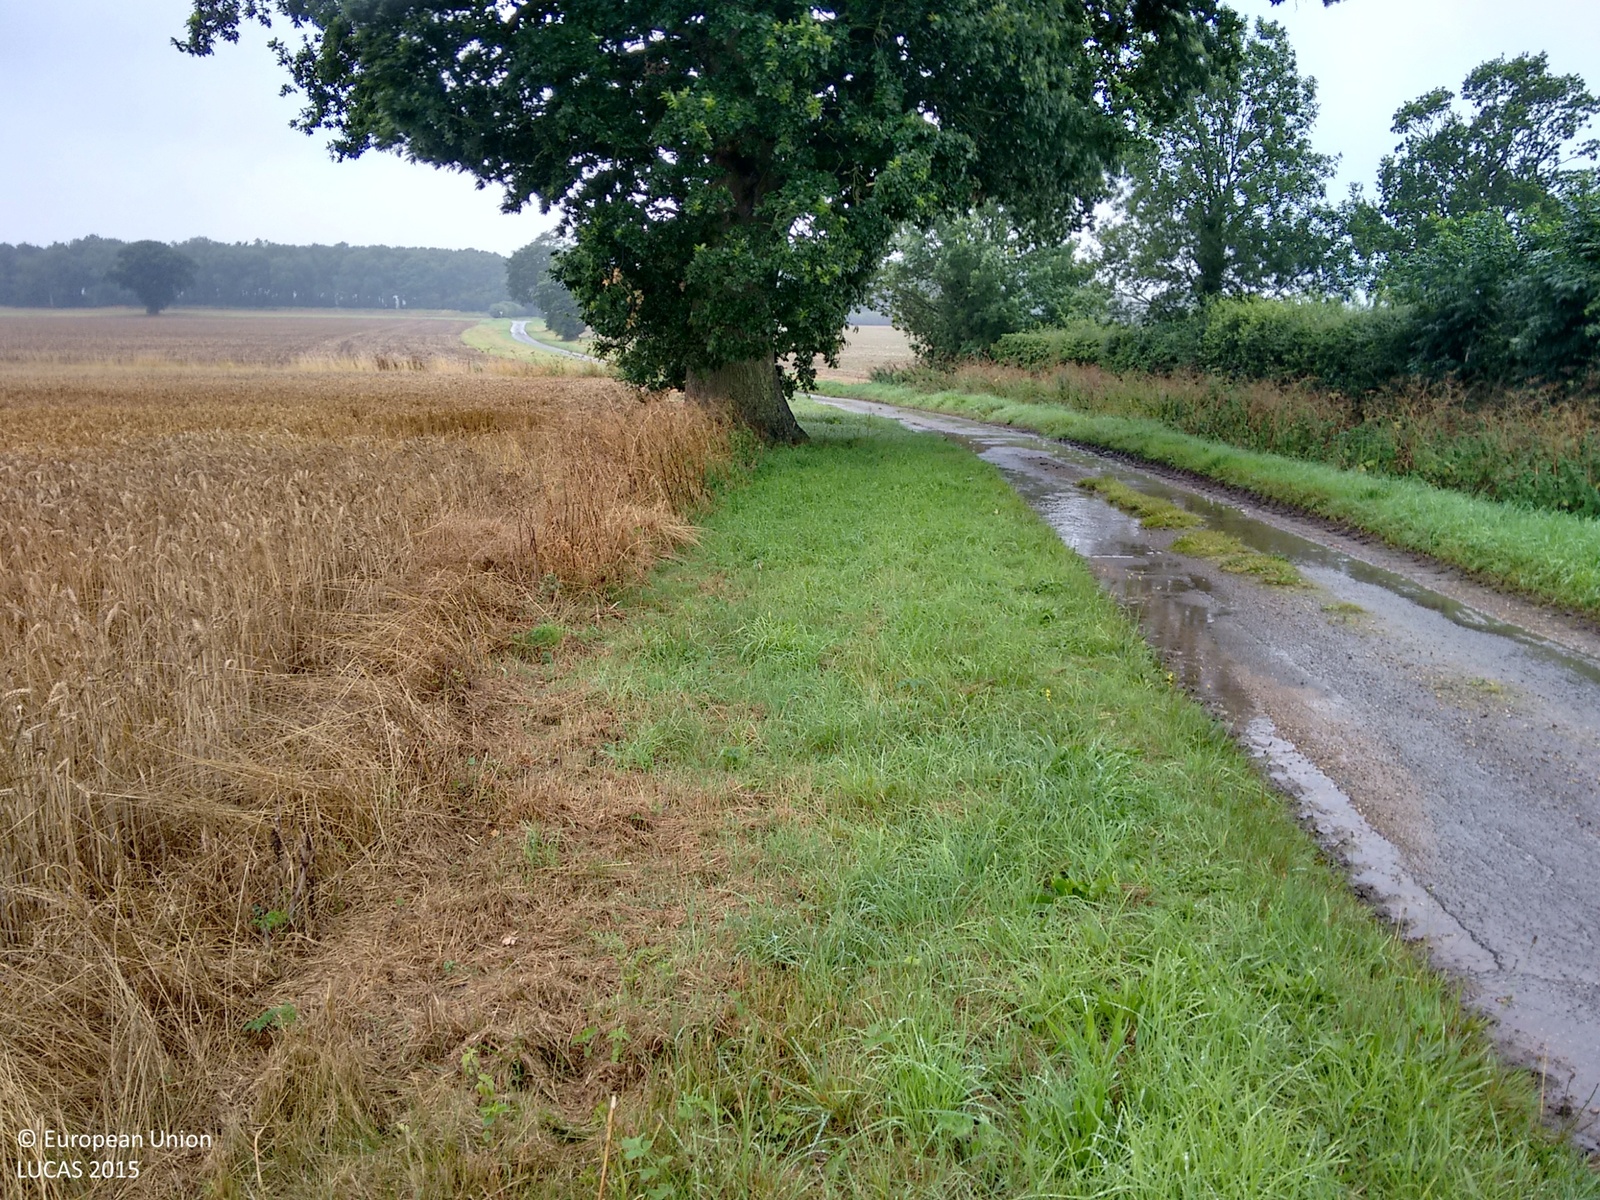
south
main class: Cropland
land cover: Common wheat
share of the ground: > 75 %
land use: Agriculture (excluding fallow land and kitchen gardens)
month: August
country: GB
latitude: 52.8152
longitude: 0.7911
